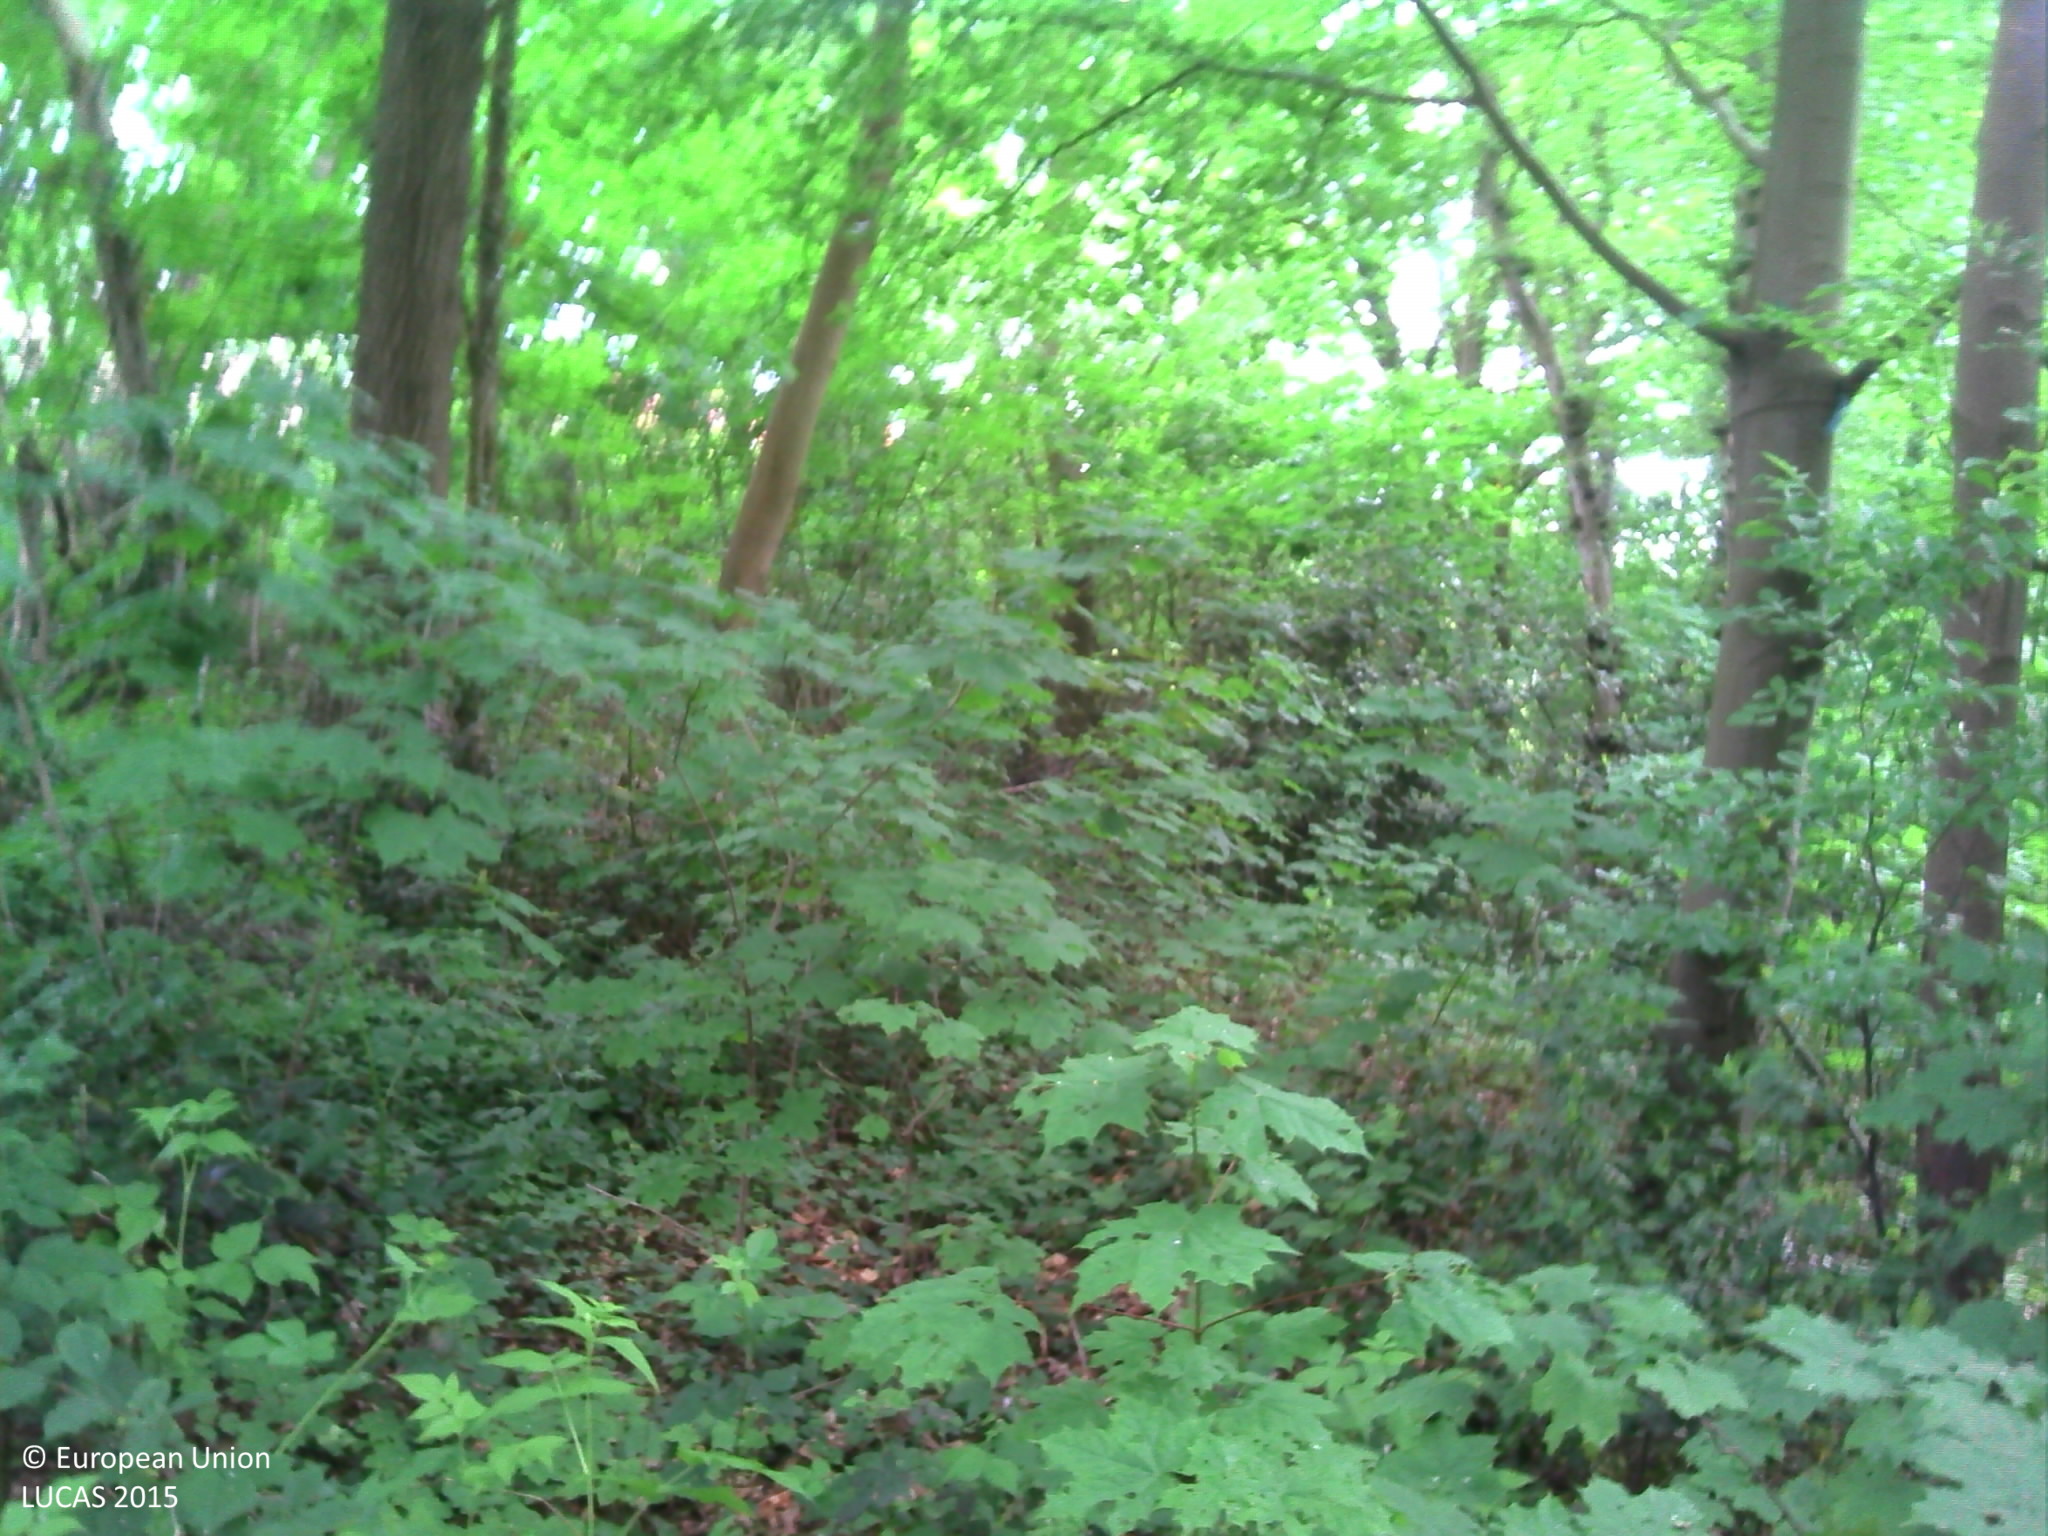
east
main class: Woodland
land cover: Broadleaved woodland
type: beech forest
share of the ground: > 75 %
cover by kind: broadleaved forest trees 100 %
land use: Forestry
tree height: > 5 m
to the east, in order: Broadleaved woodland; Fences; Artificial constructions in urban areas; Broadleaved woodland; Artificial constructions in urban areas
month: May
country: BE
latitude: 50.6819
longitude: 4.4903
